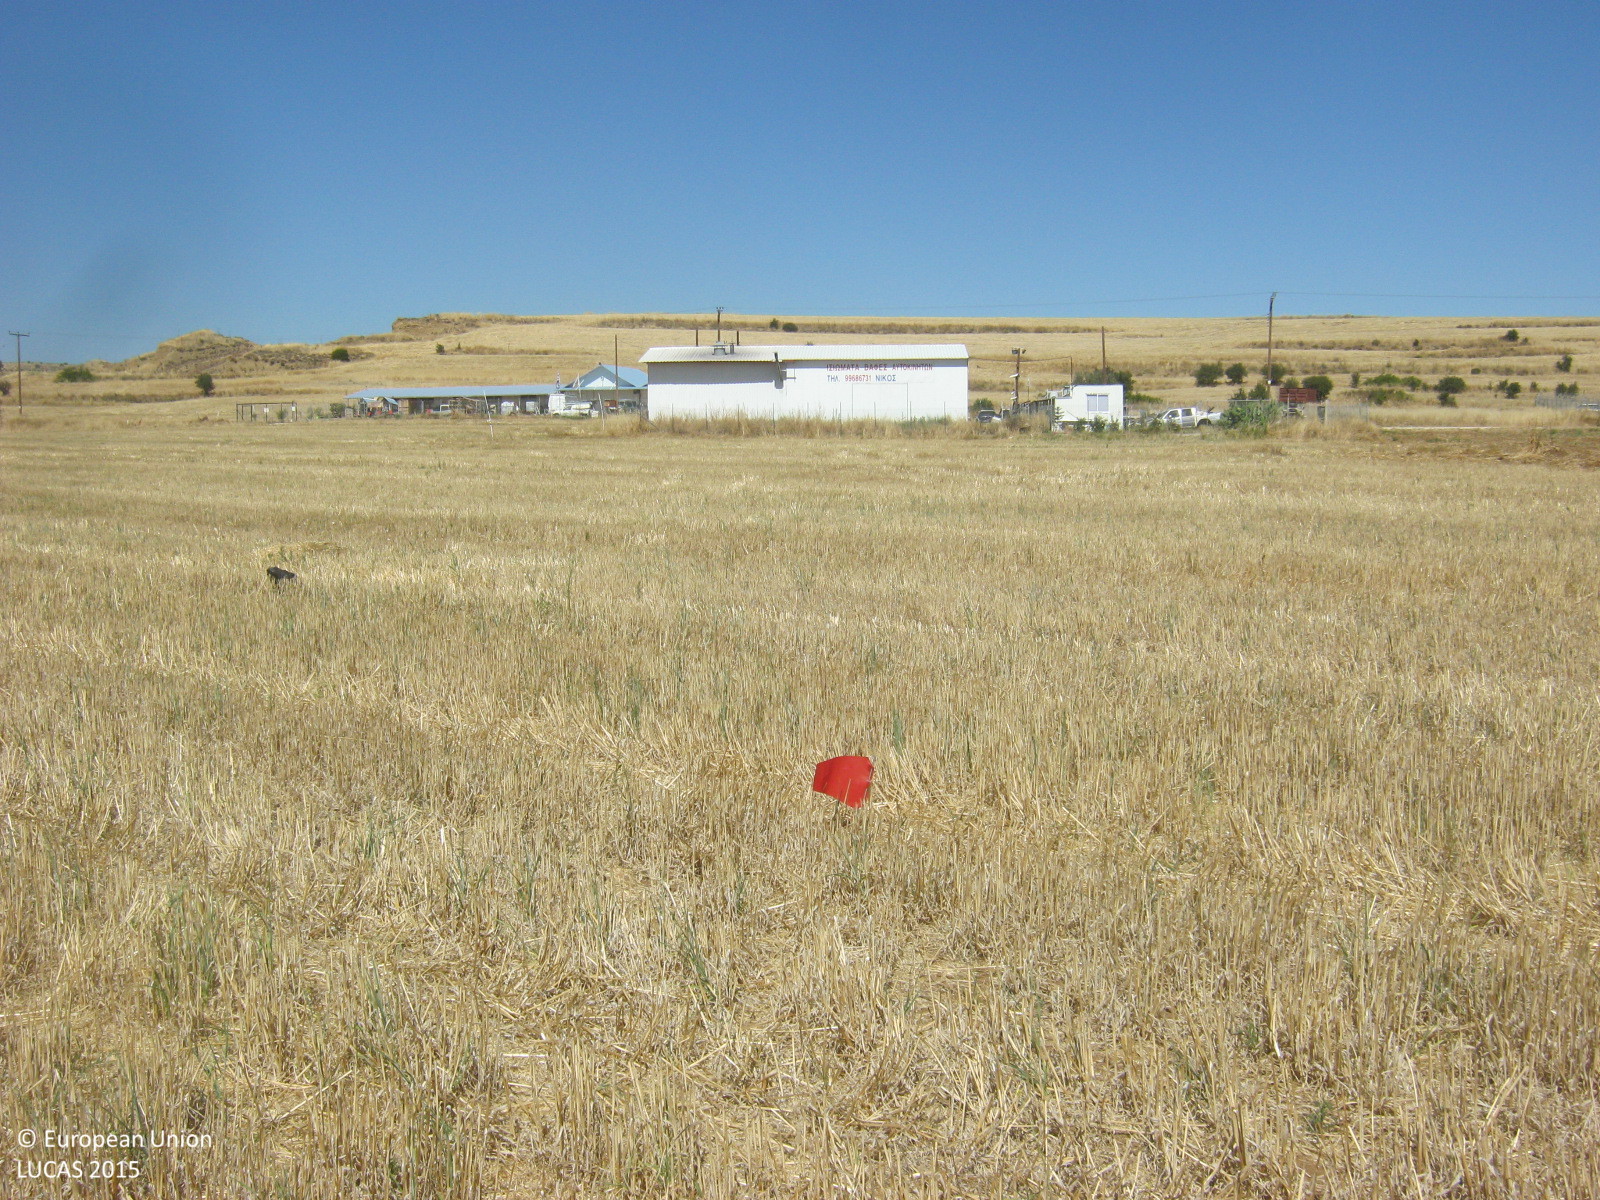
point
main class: Cropland
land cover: Barley
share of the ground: < 10 %
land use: Agriculture (excluding fallow land and kitchen gardens)
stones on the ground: < 10 %
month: June
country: CY
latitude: 35.0325
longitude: 33.1669
